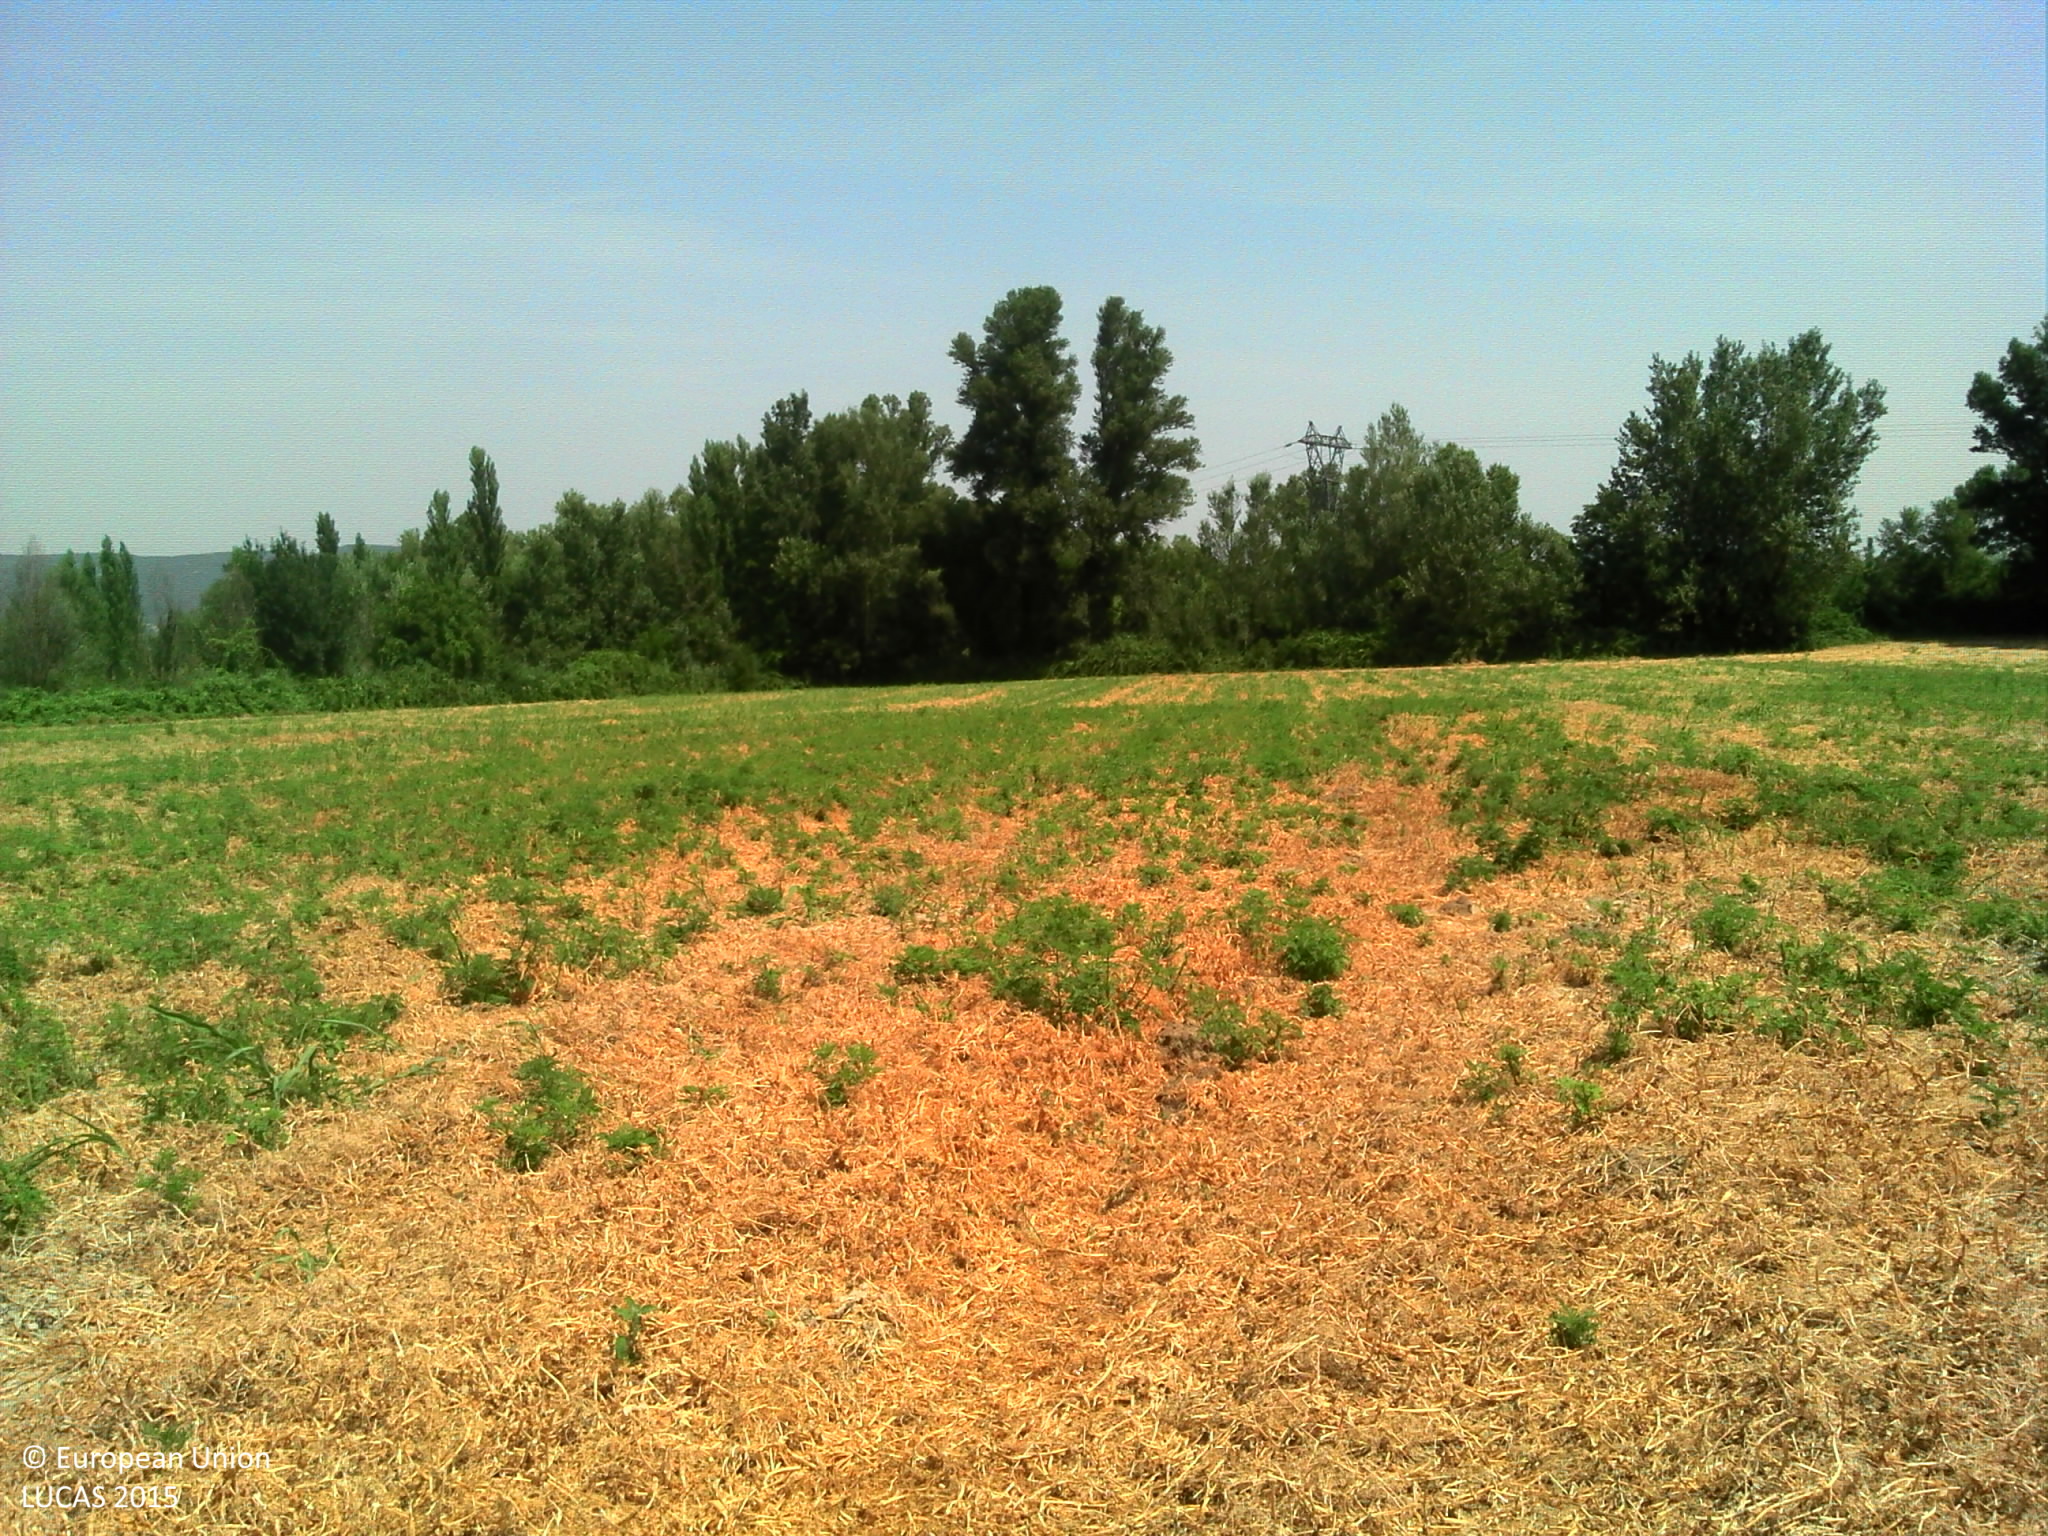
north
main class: Cropland
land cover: Dry pulses
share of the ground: > 75 %
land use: Agriculture (excluding fallow land and kitchen gardens)
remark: Harvested field
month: July
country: FR
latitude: 44.4136
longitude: 4.6949
